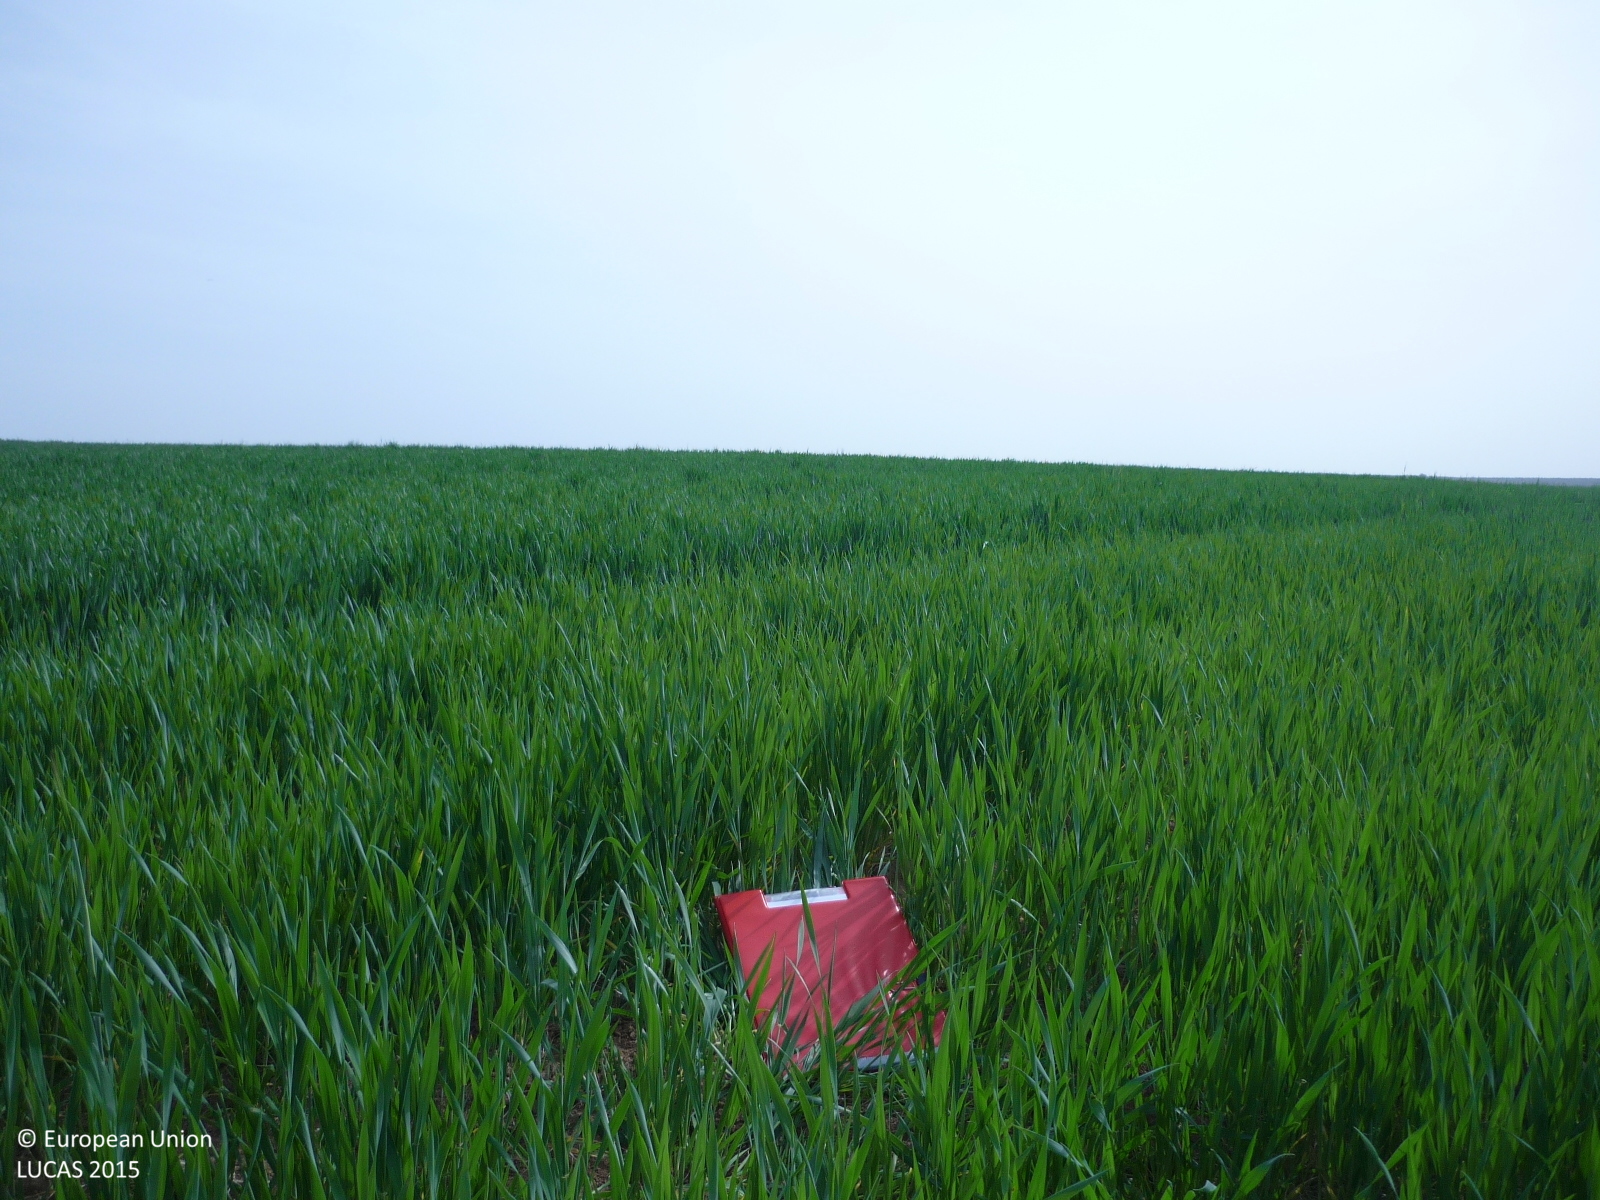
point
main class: Cropland
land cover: Barley
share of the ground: > 75 %
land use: Agriculture (excluding fallow land and kitchen gardens)
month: April
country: ES
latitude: 40.6210
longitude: -3.4298
